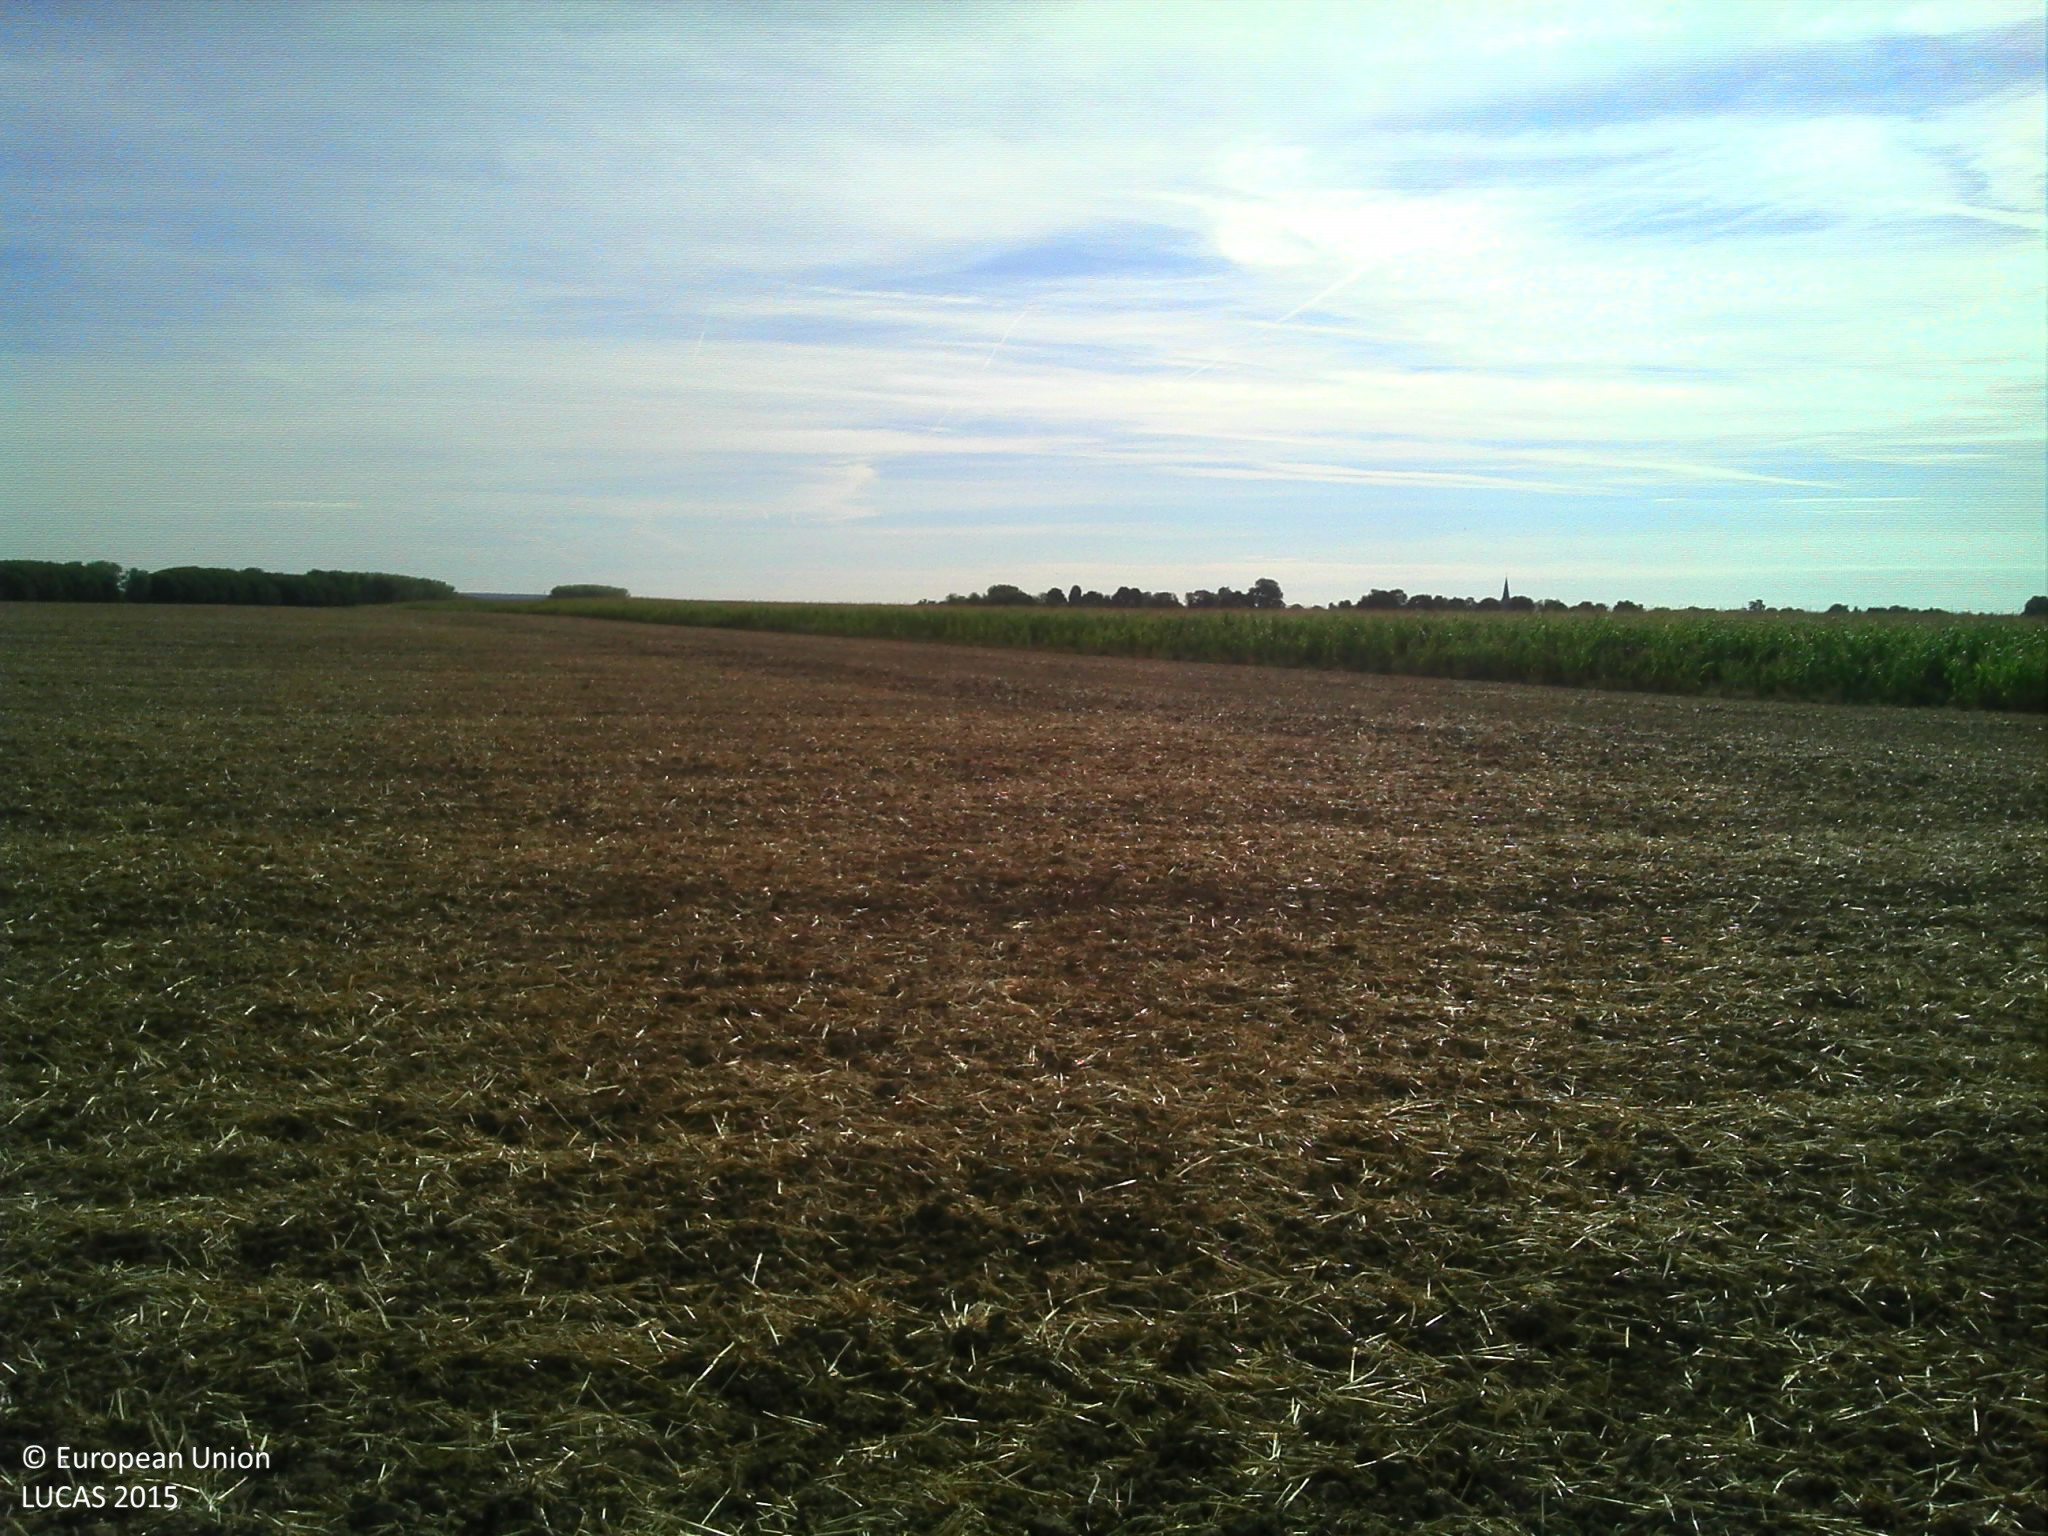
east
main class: Cropland
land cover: Common wheat
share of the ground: > 75 %
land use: Agriculture (excluding fallow land and kitchen gardens)
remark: Harvested field
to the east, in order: Common wheat; Maize
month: August
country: FR
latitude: 48.9862
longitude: 2.5963
